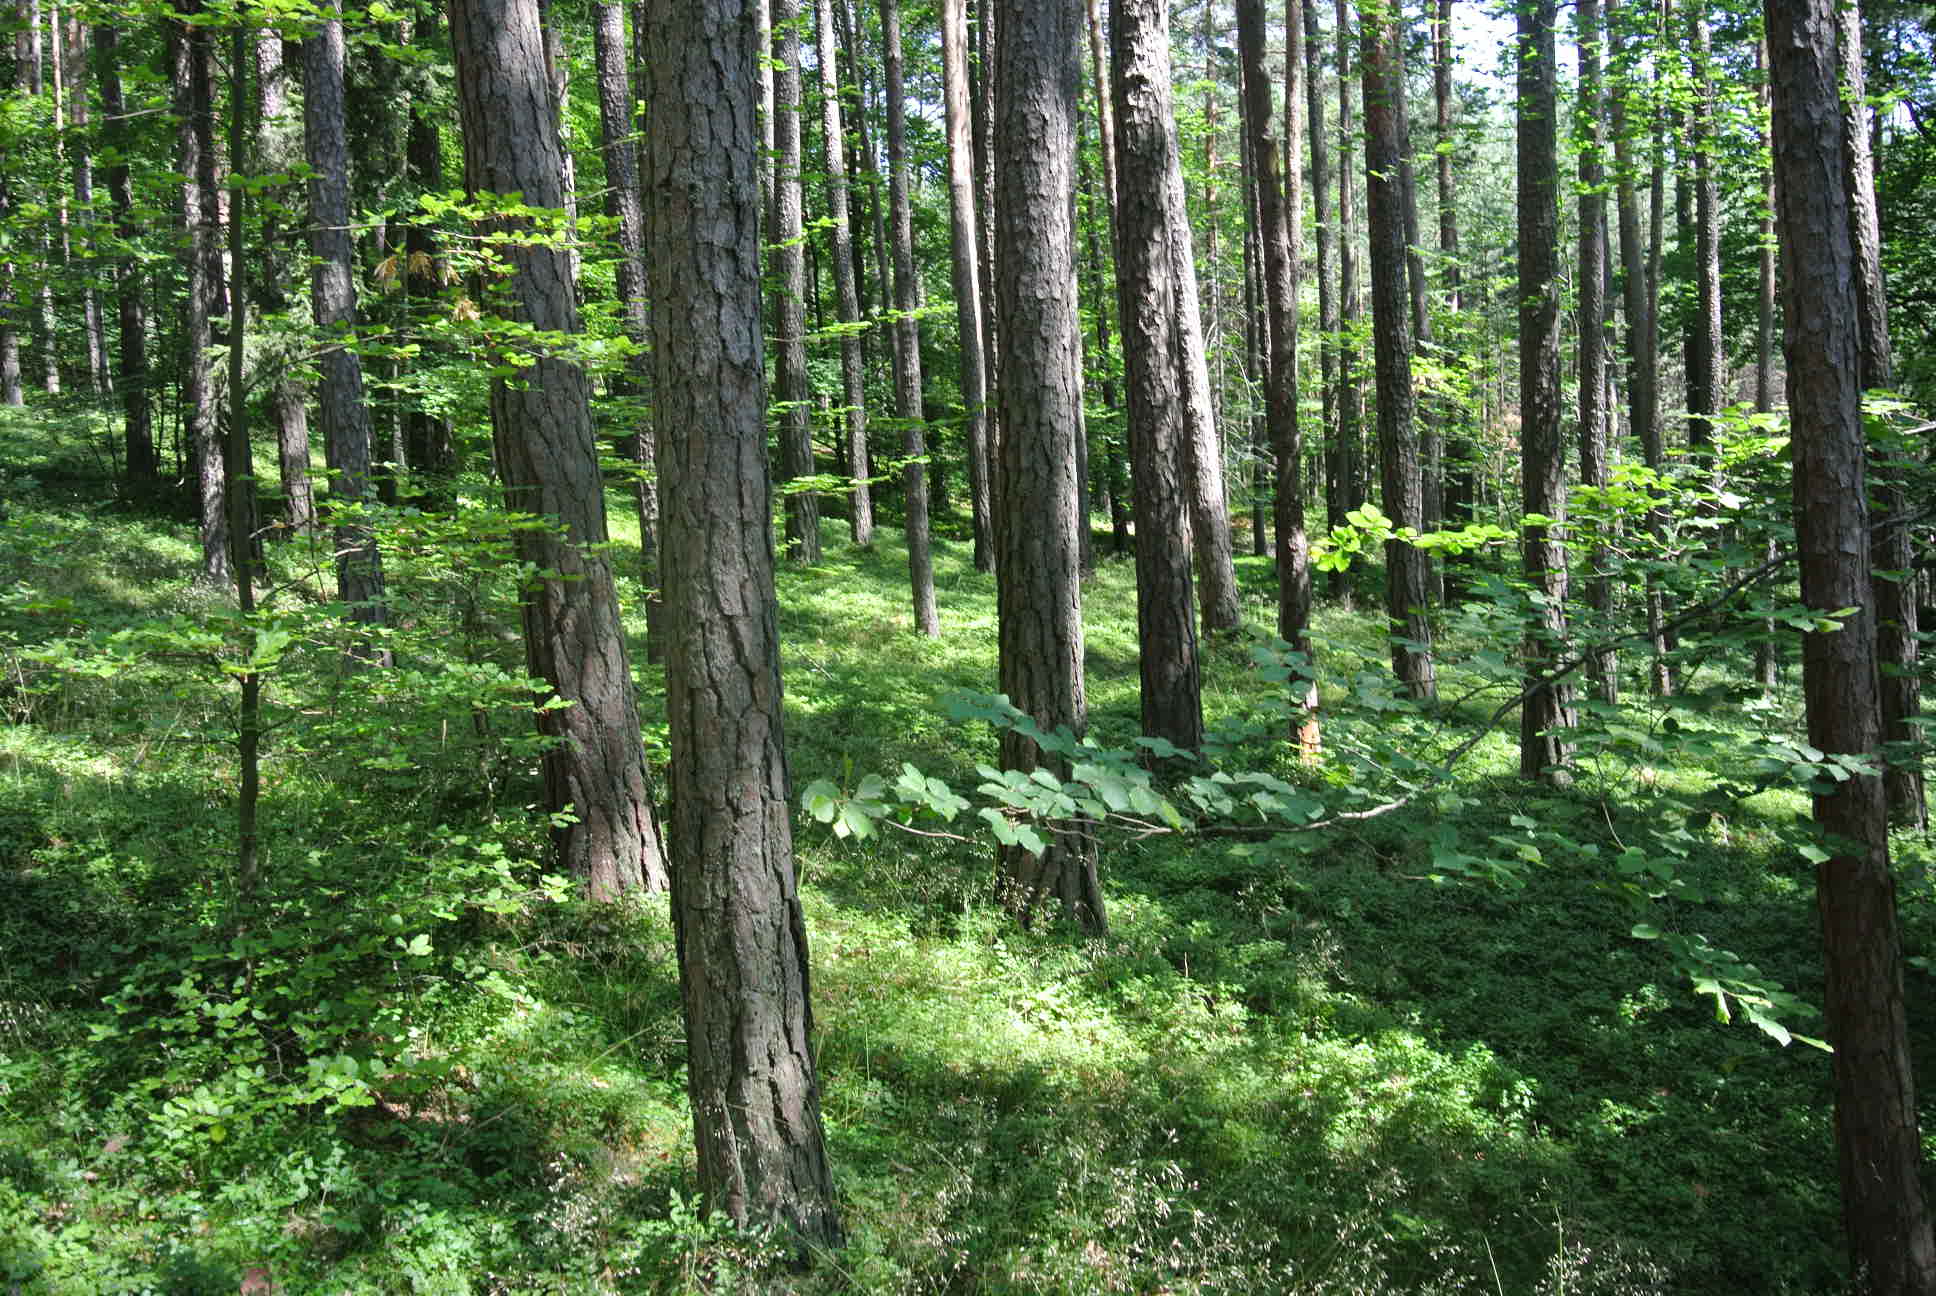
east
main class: Woodland
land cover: Pine dominated coniferous woodland
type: alpine coniferous forest
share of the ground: > 75 %
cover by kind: coniferous forest trees 85 %, broadleaved forest trees 10 %, lichens and mosses 5 %
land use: Forestry
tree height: > 5 m
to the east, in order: Pine dominated coniferous woodland; Tracks; Pine dominated coniferous woodland; Tracks; Pine dominated mixed woodland; Tracks; Pine dominated mixed woodland; Broadleaved woodland; Grassland without tree/shrub cover
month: July
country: AT
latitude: 47.6045
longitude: 16.0815
